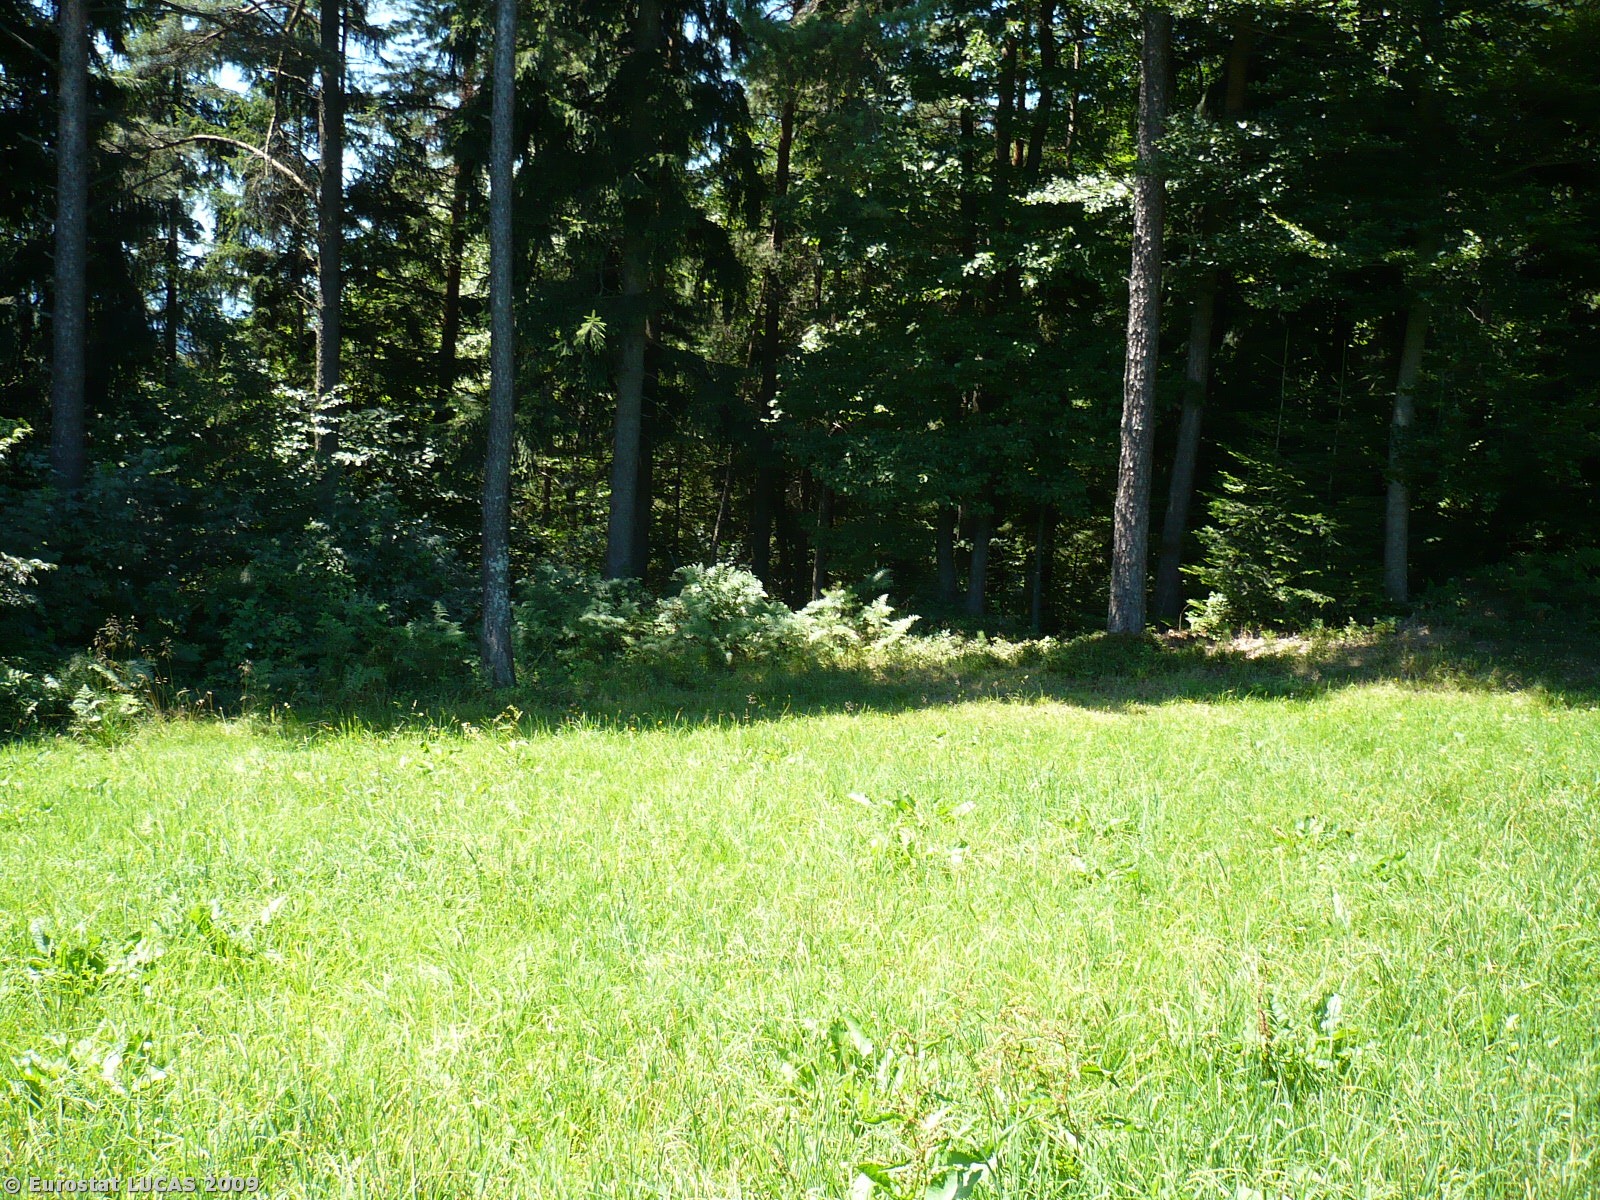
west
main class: Grassland
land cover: Grassland without tree/shrub cover
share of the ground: > 75 %
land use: Agriculture (excluding fallow land and kitchen gardens)
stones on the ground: 10 - 25 %
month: July
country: SI
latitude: 46.6508
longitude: 15.3429
